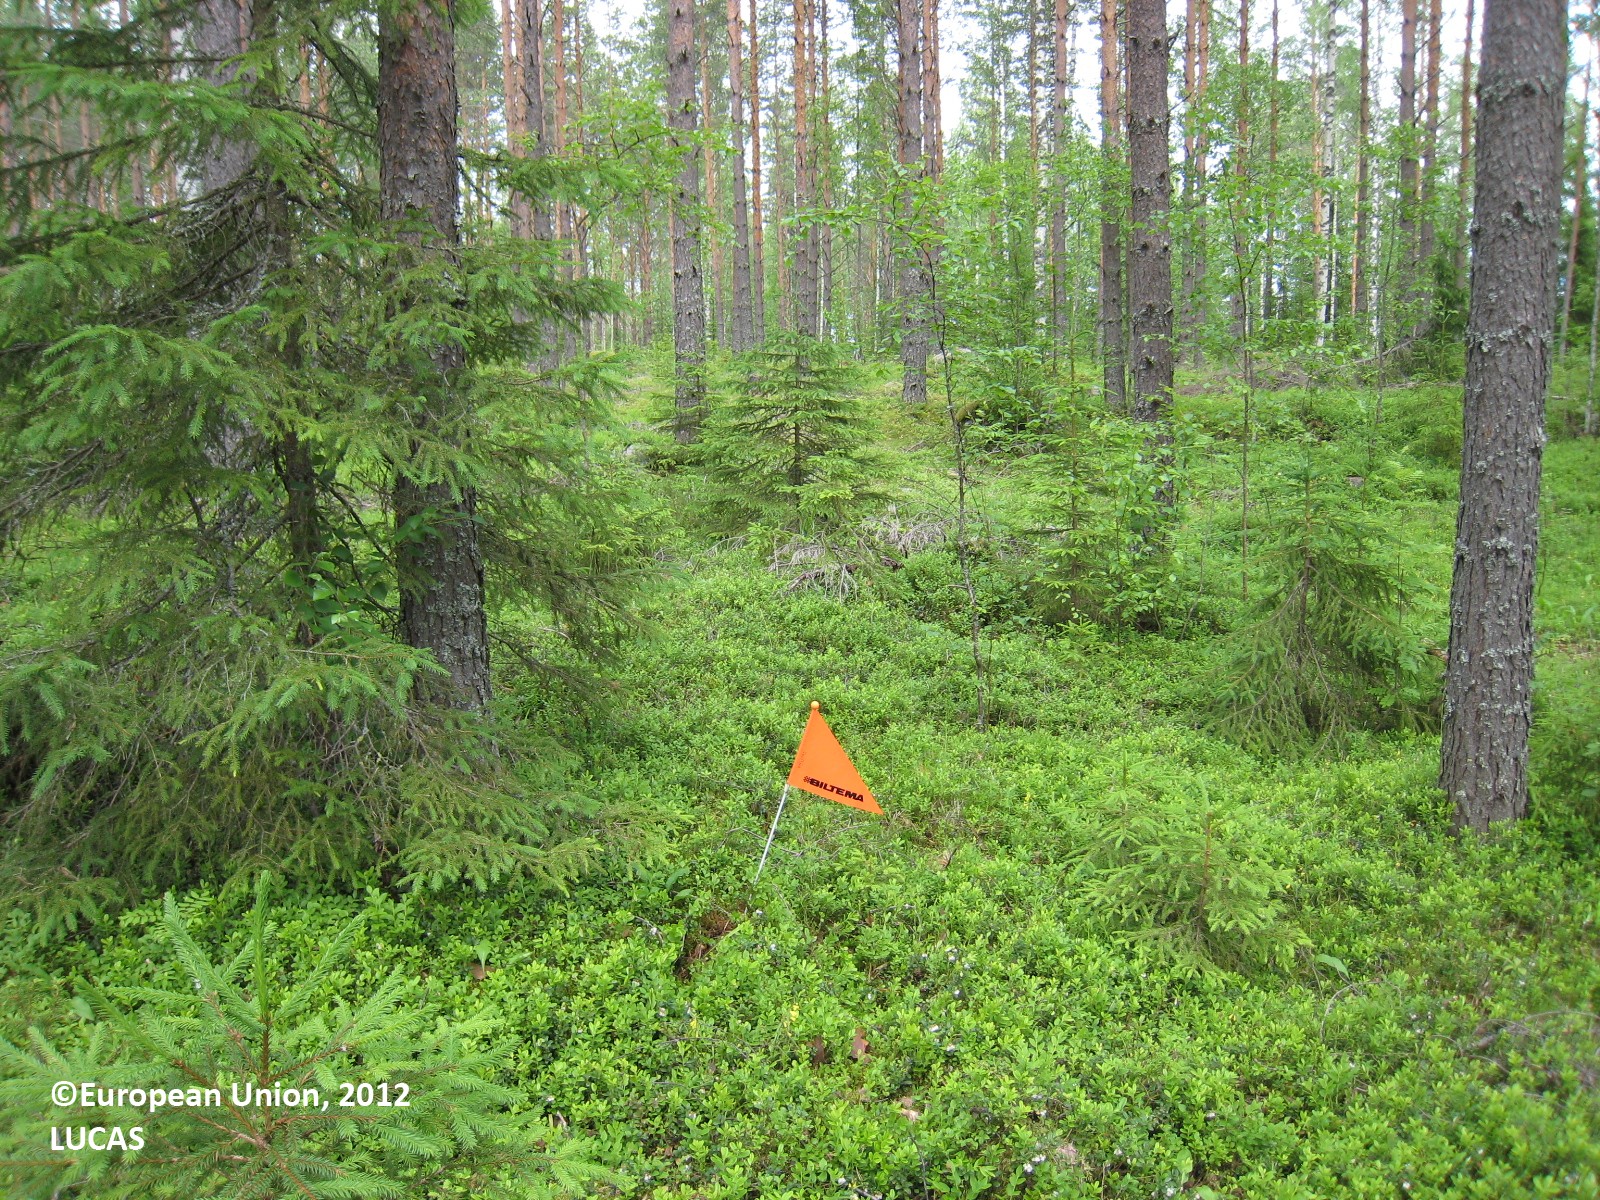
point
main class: Woodland
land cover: Pine dominated coniferous woodland
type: boreal forest
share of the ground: 25 - 50 %
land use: Forestry
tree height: > 5 m
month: June
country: FI
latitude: 62.0130
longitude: 26.2775
